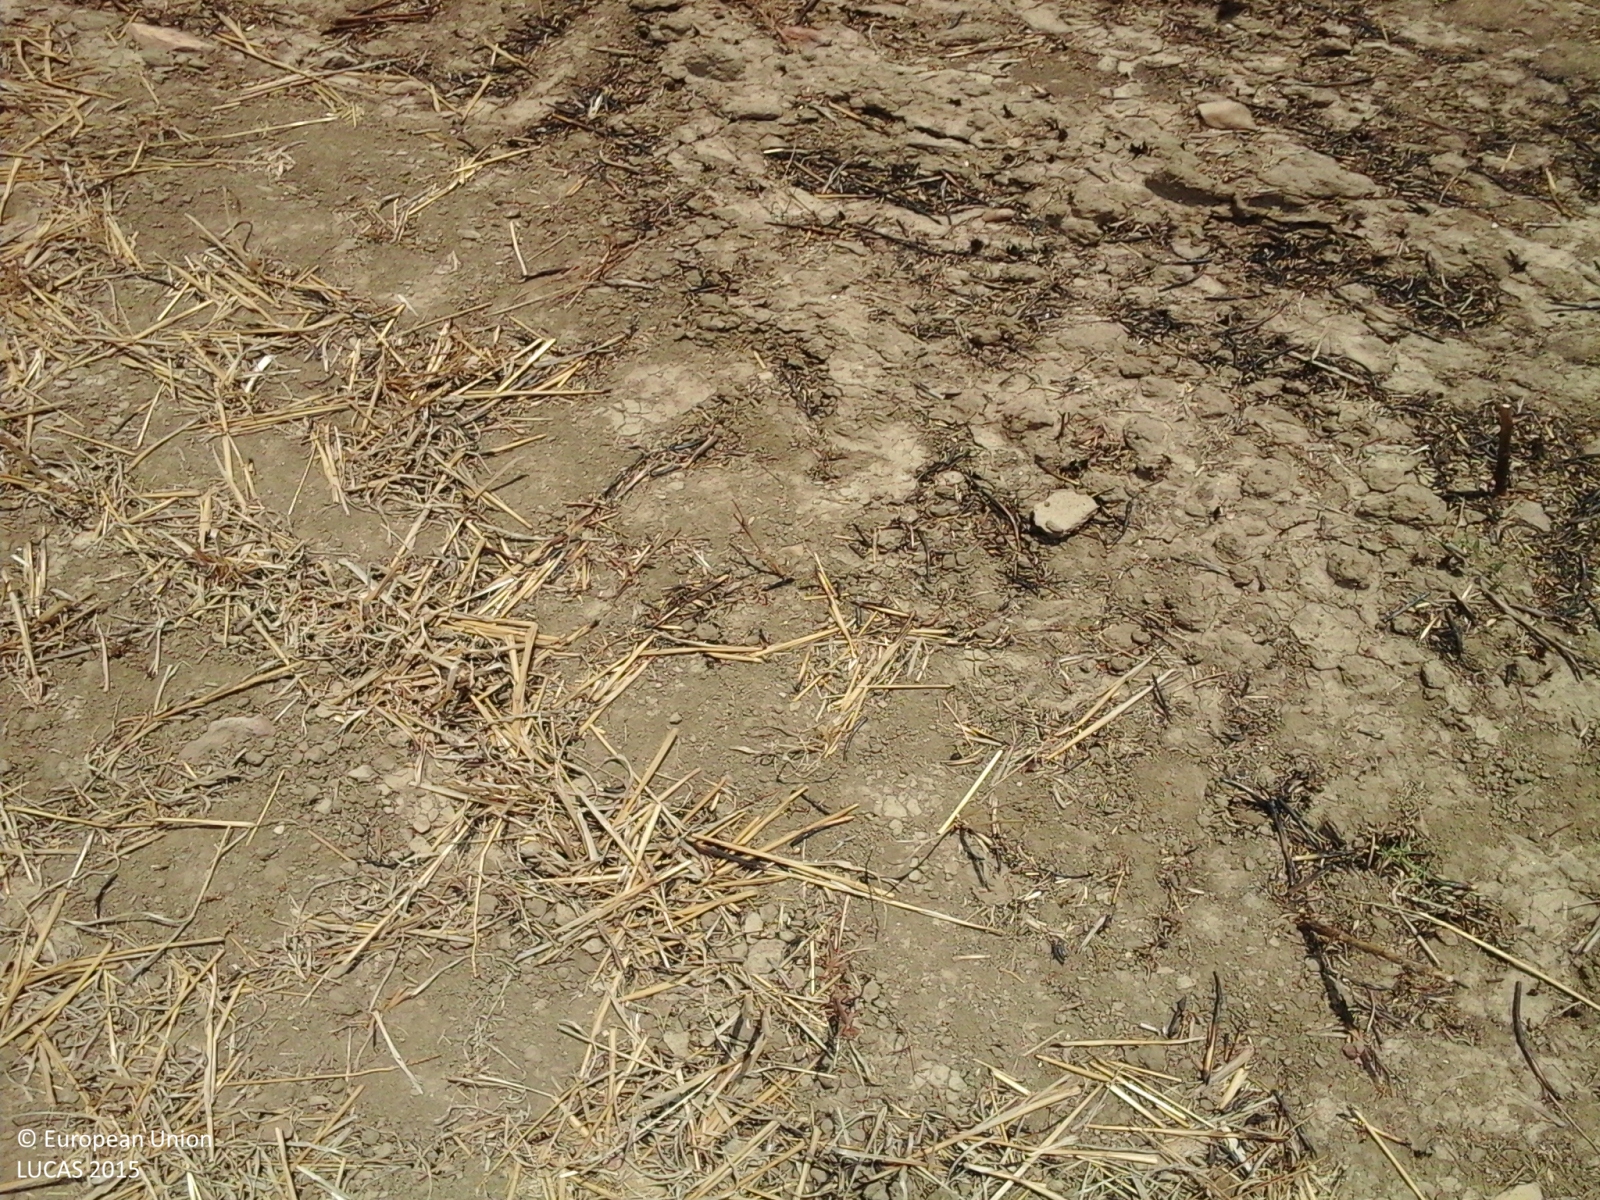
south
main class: Cropland
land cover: Durum wheat
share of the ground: > 75 %
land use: Agriculture (excluding fallow land and kitchen gardens)
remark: Burnt area
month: July
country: IT
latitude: 37.1562
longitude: 14.3687
